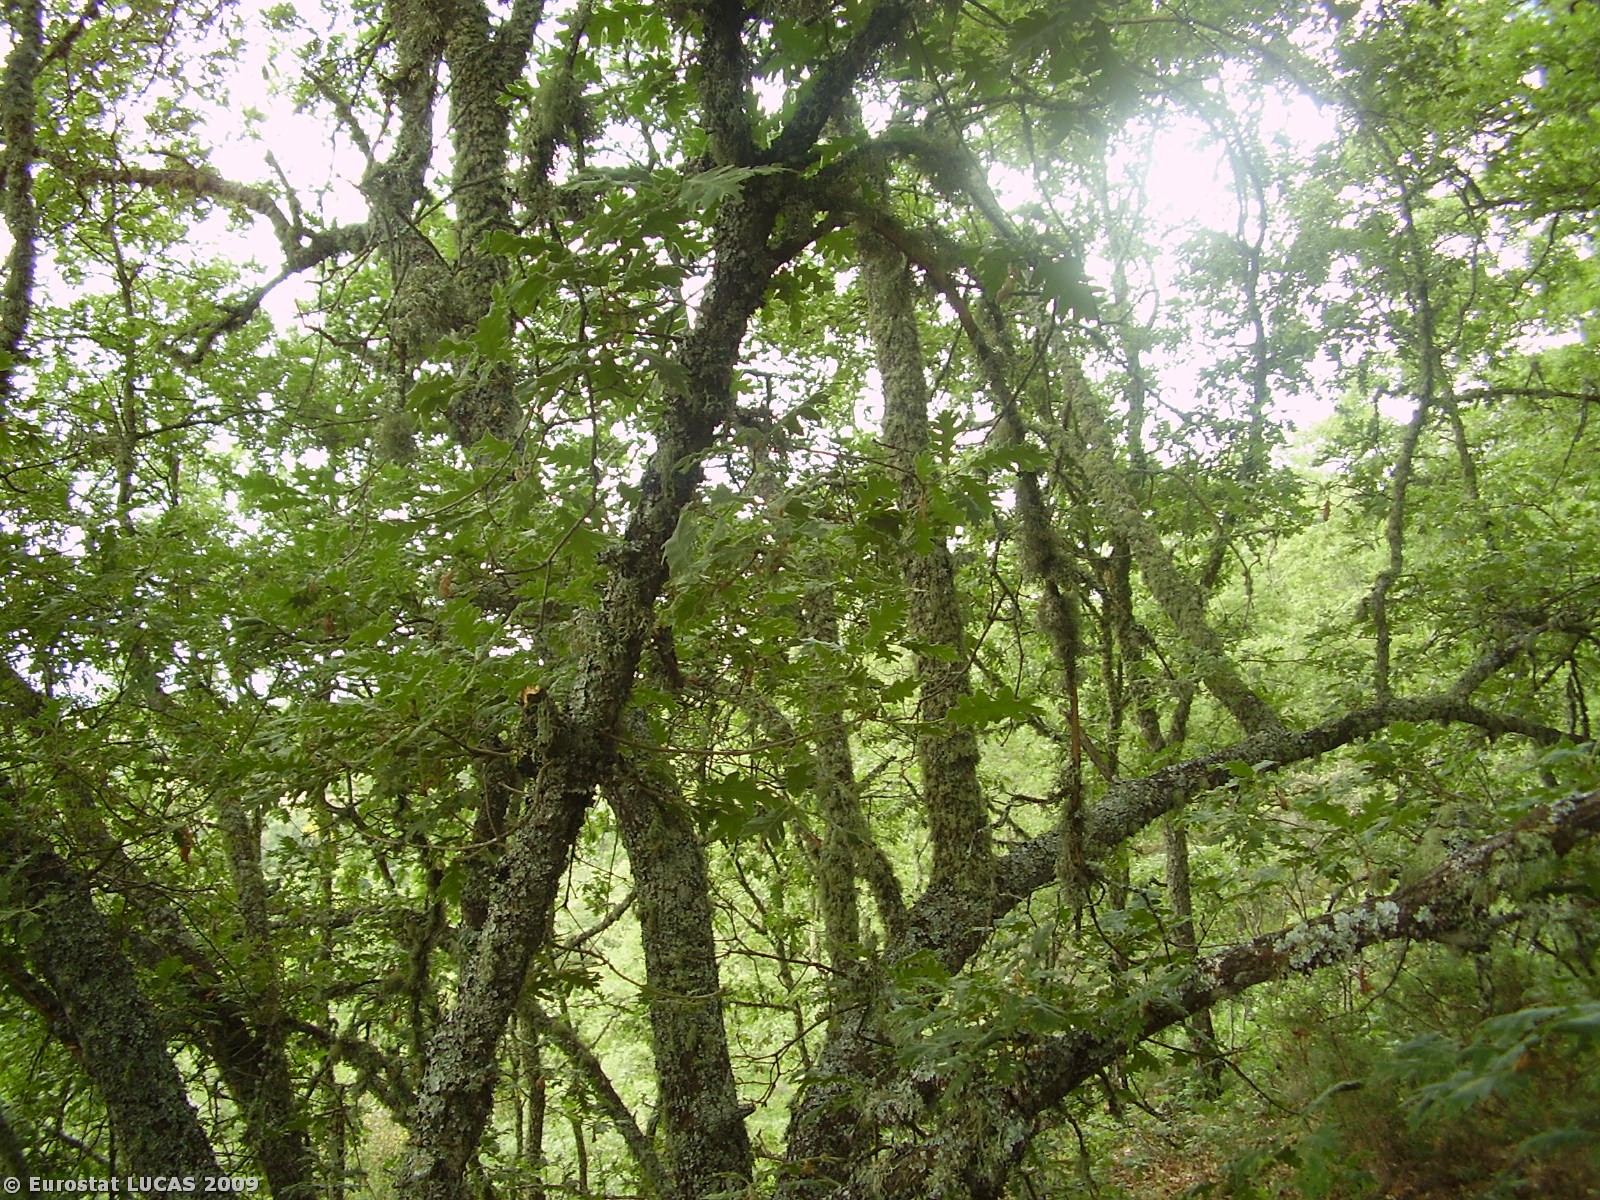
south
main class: Woodland
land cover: Broadleaved woodland
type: acidophilous oak and oak-birch forest
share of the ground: > 75 %
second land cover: Spontaneously vegetated surfaces
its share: 25 - 50 %
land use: Forestry
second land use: Nature reserves
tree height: > 5 m
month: June
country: PT
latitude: 41.7122
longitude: -6.8317
